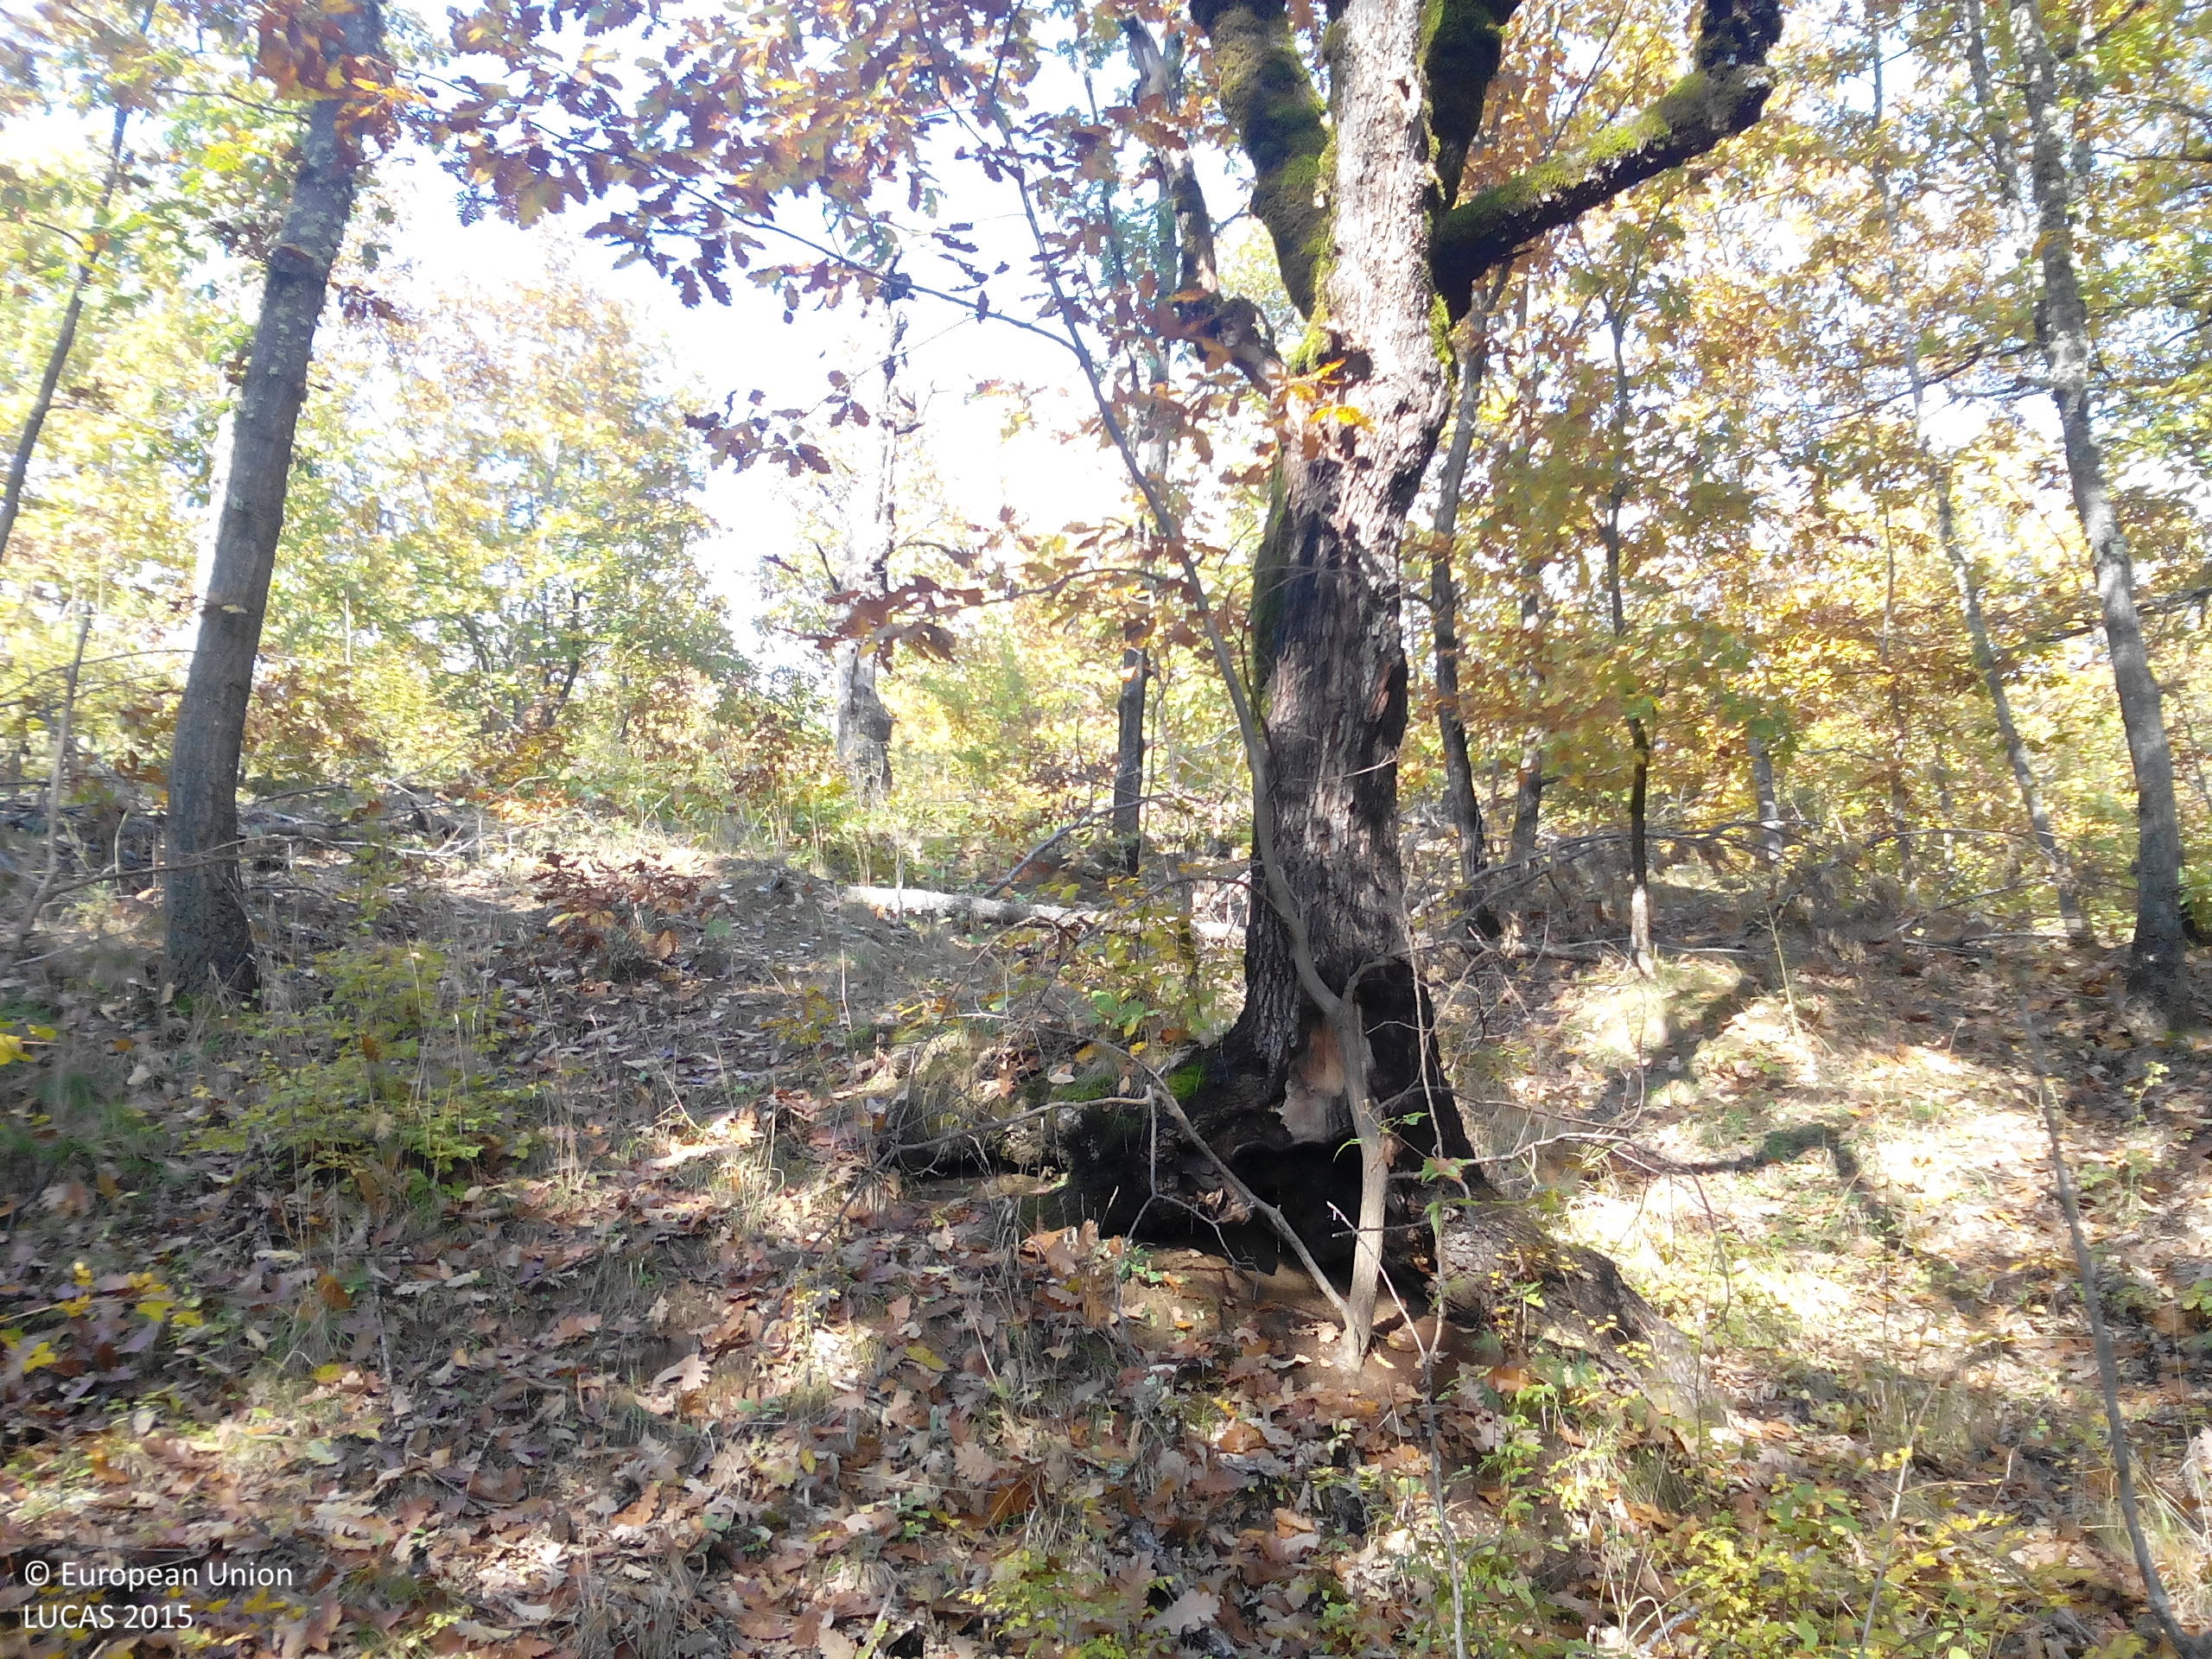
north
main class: Woodland
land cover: Broadleaved woodland
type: acidophilous oak and oak-birch forest
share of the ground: > 75 %
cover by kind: broadleaved forest trees 95 %, shrubs 5 %
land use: Forestry
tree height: > 5 m
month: October
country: BG
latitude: 43.0678
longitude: 24.5113
